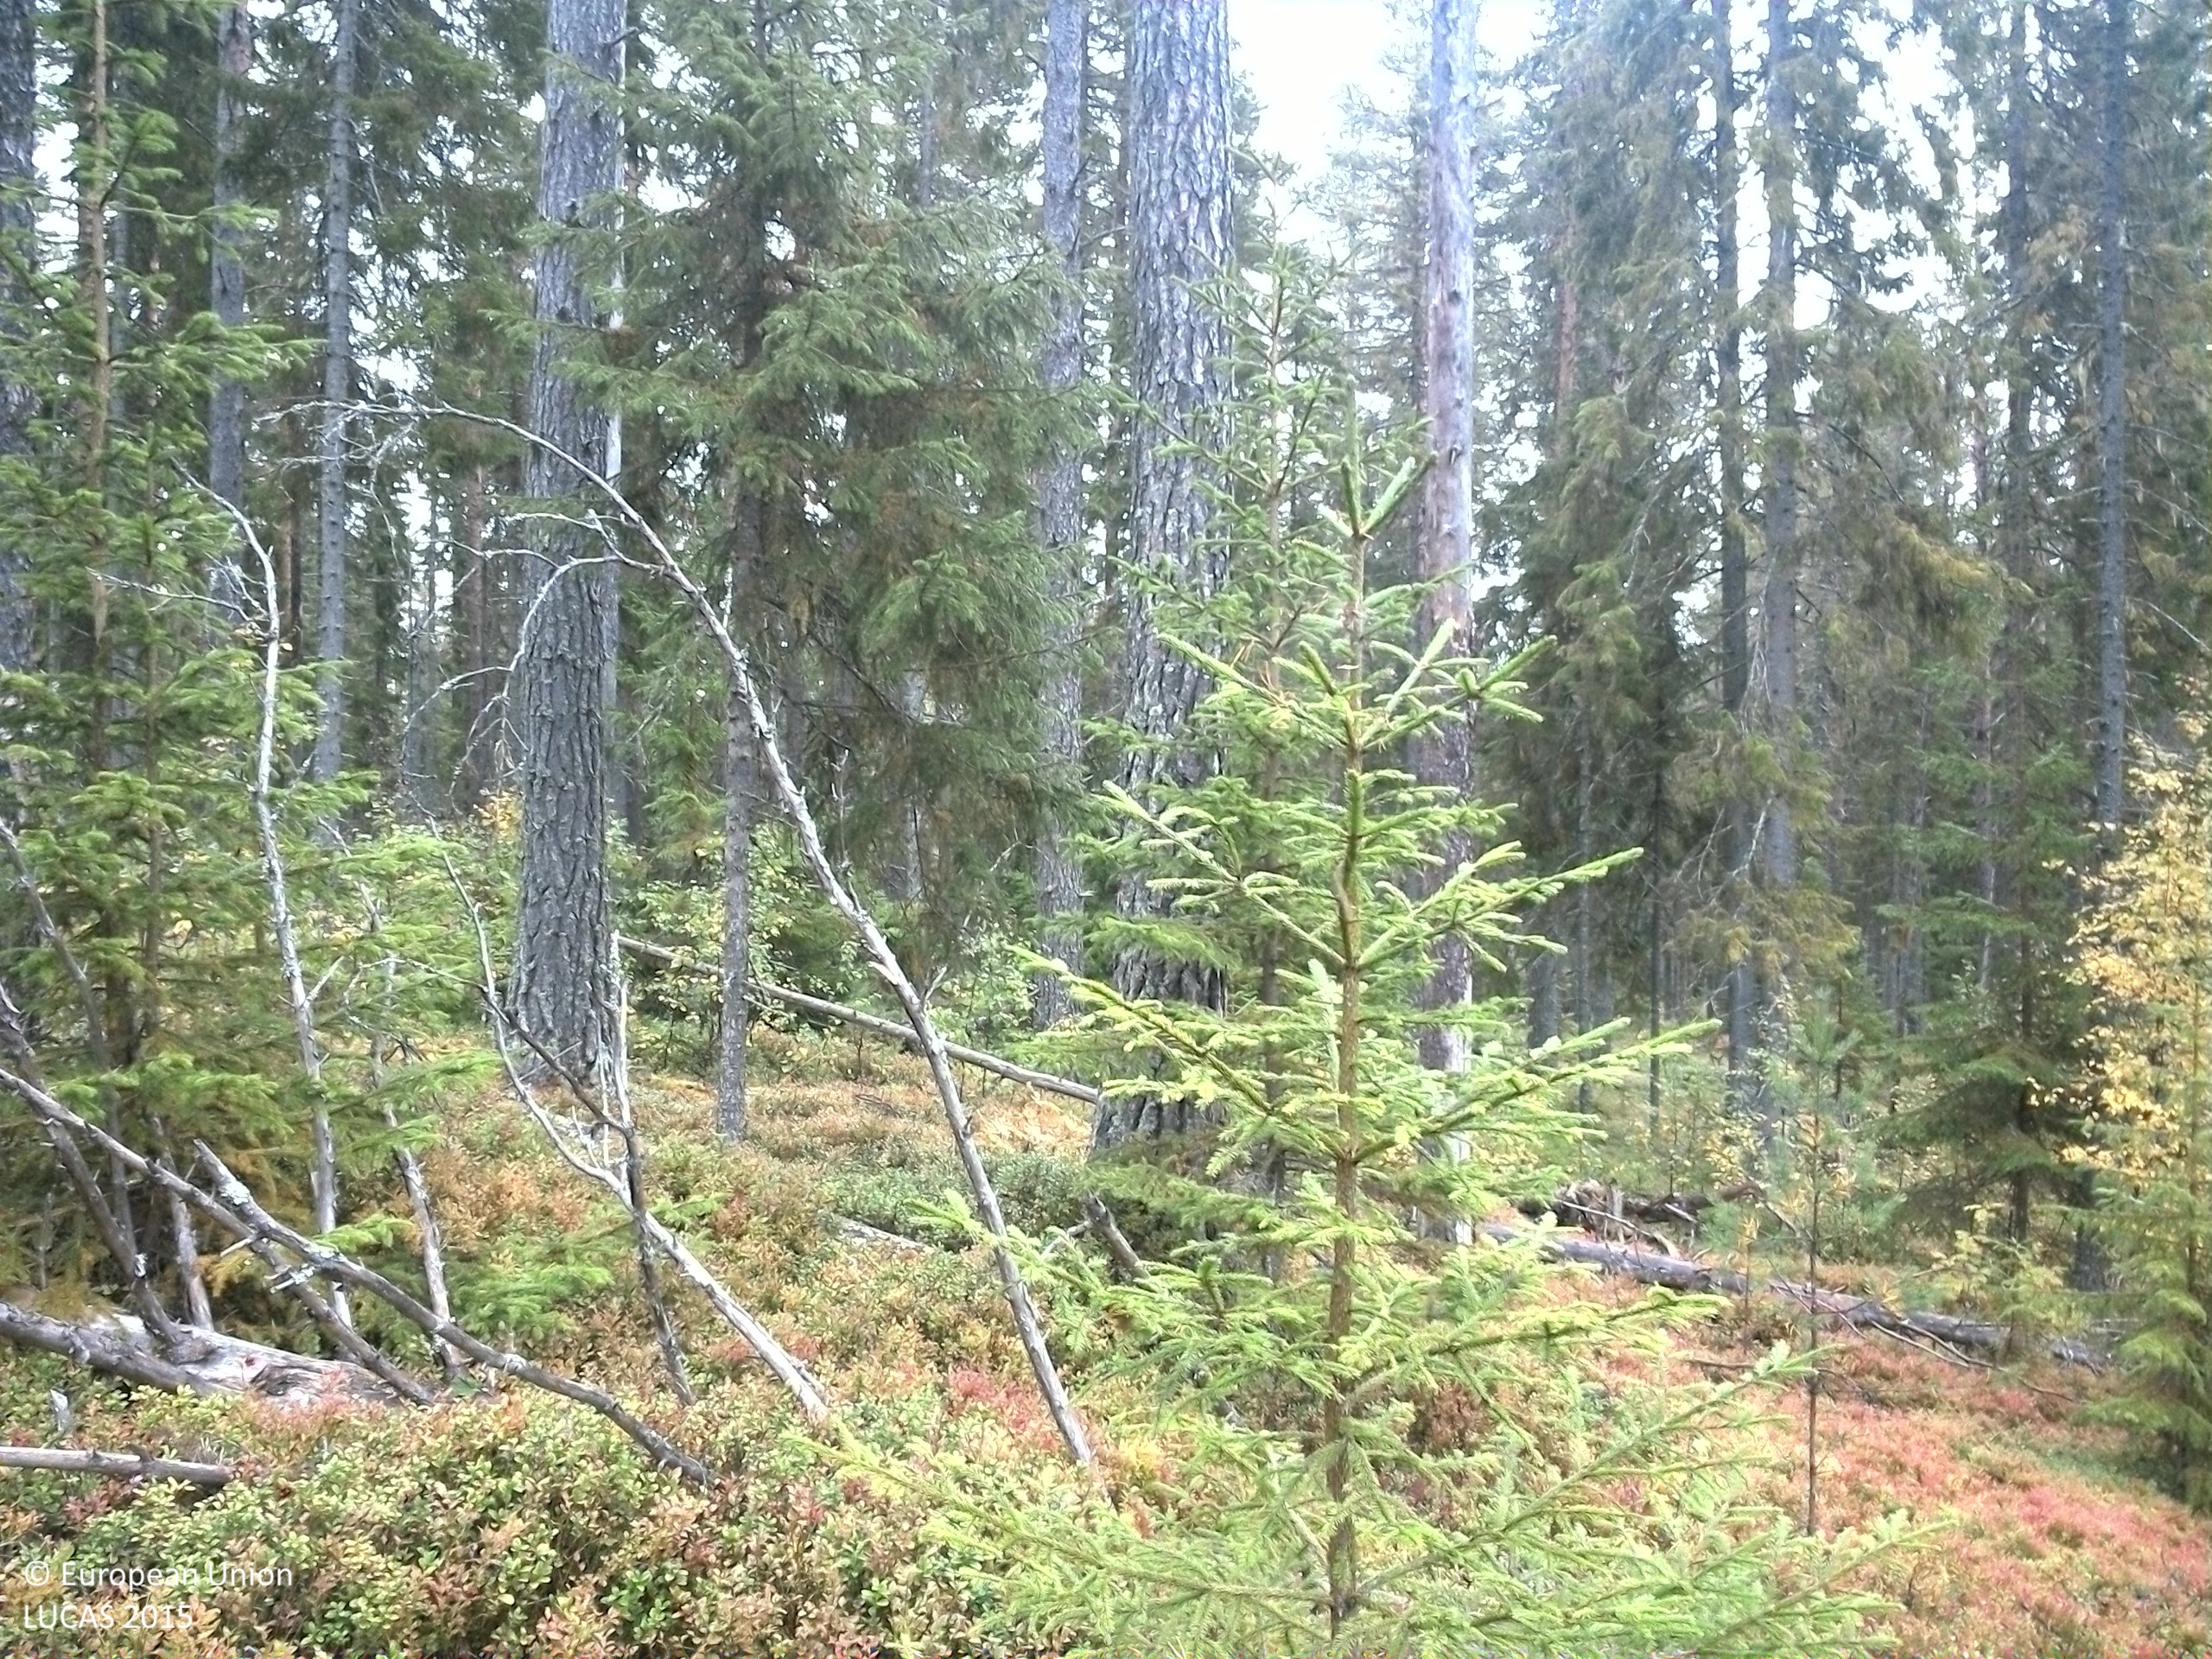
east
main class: Woodland
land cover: Pine dominated coniferous woodland
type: boreal forest
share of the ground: 50 - 75 %
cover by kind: coniferous forest trees 45 %, shrubs 35 %, broadleaved forest trees 10 %, lichens and mosses 10 %
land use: Forestry
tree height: > 5 m
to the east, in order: Pine dominated coniferous woodland; Spruce dominated mixed woodland; Broadleaved woodland; Inland fresh water bodies; Electric lines; Inland fresh water bodies
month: September
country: SE
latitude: 63.6785
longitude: 16.2192
